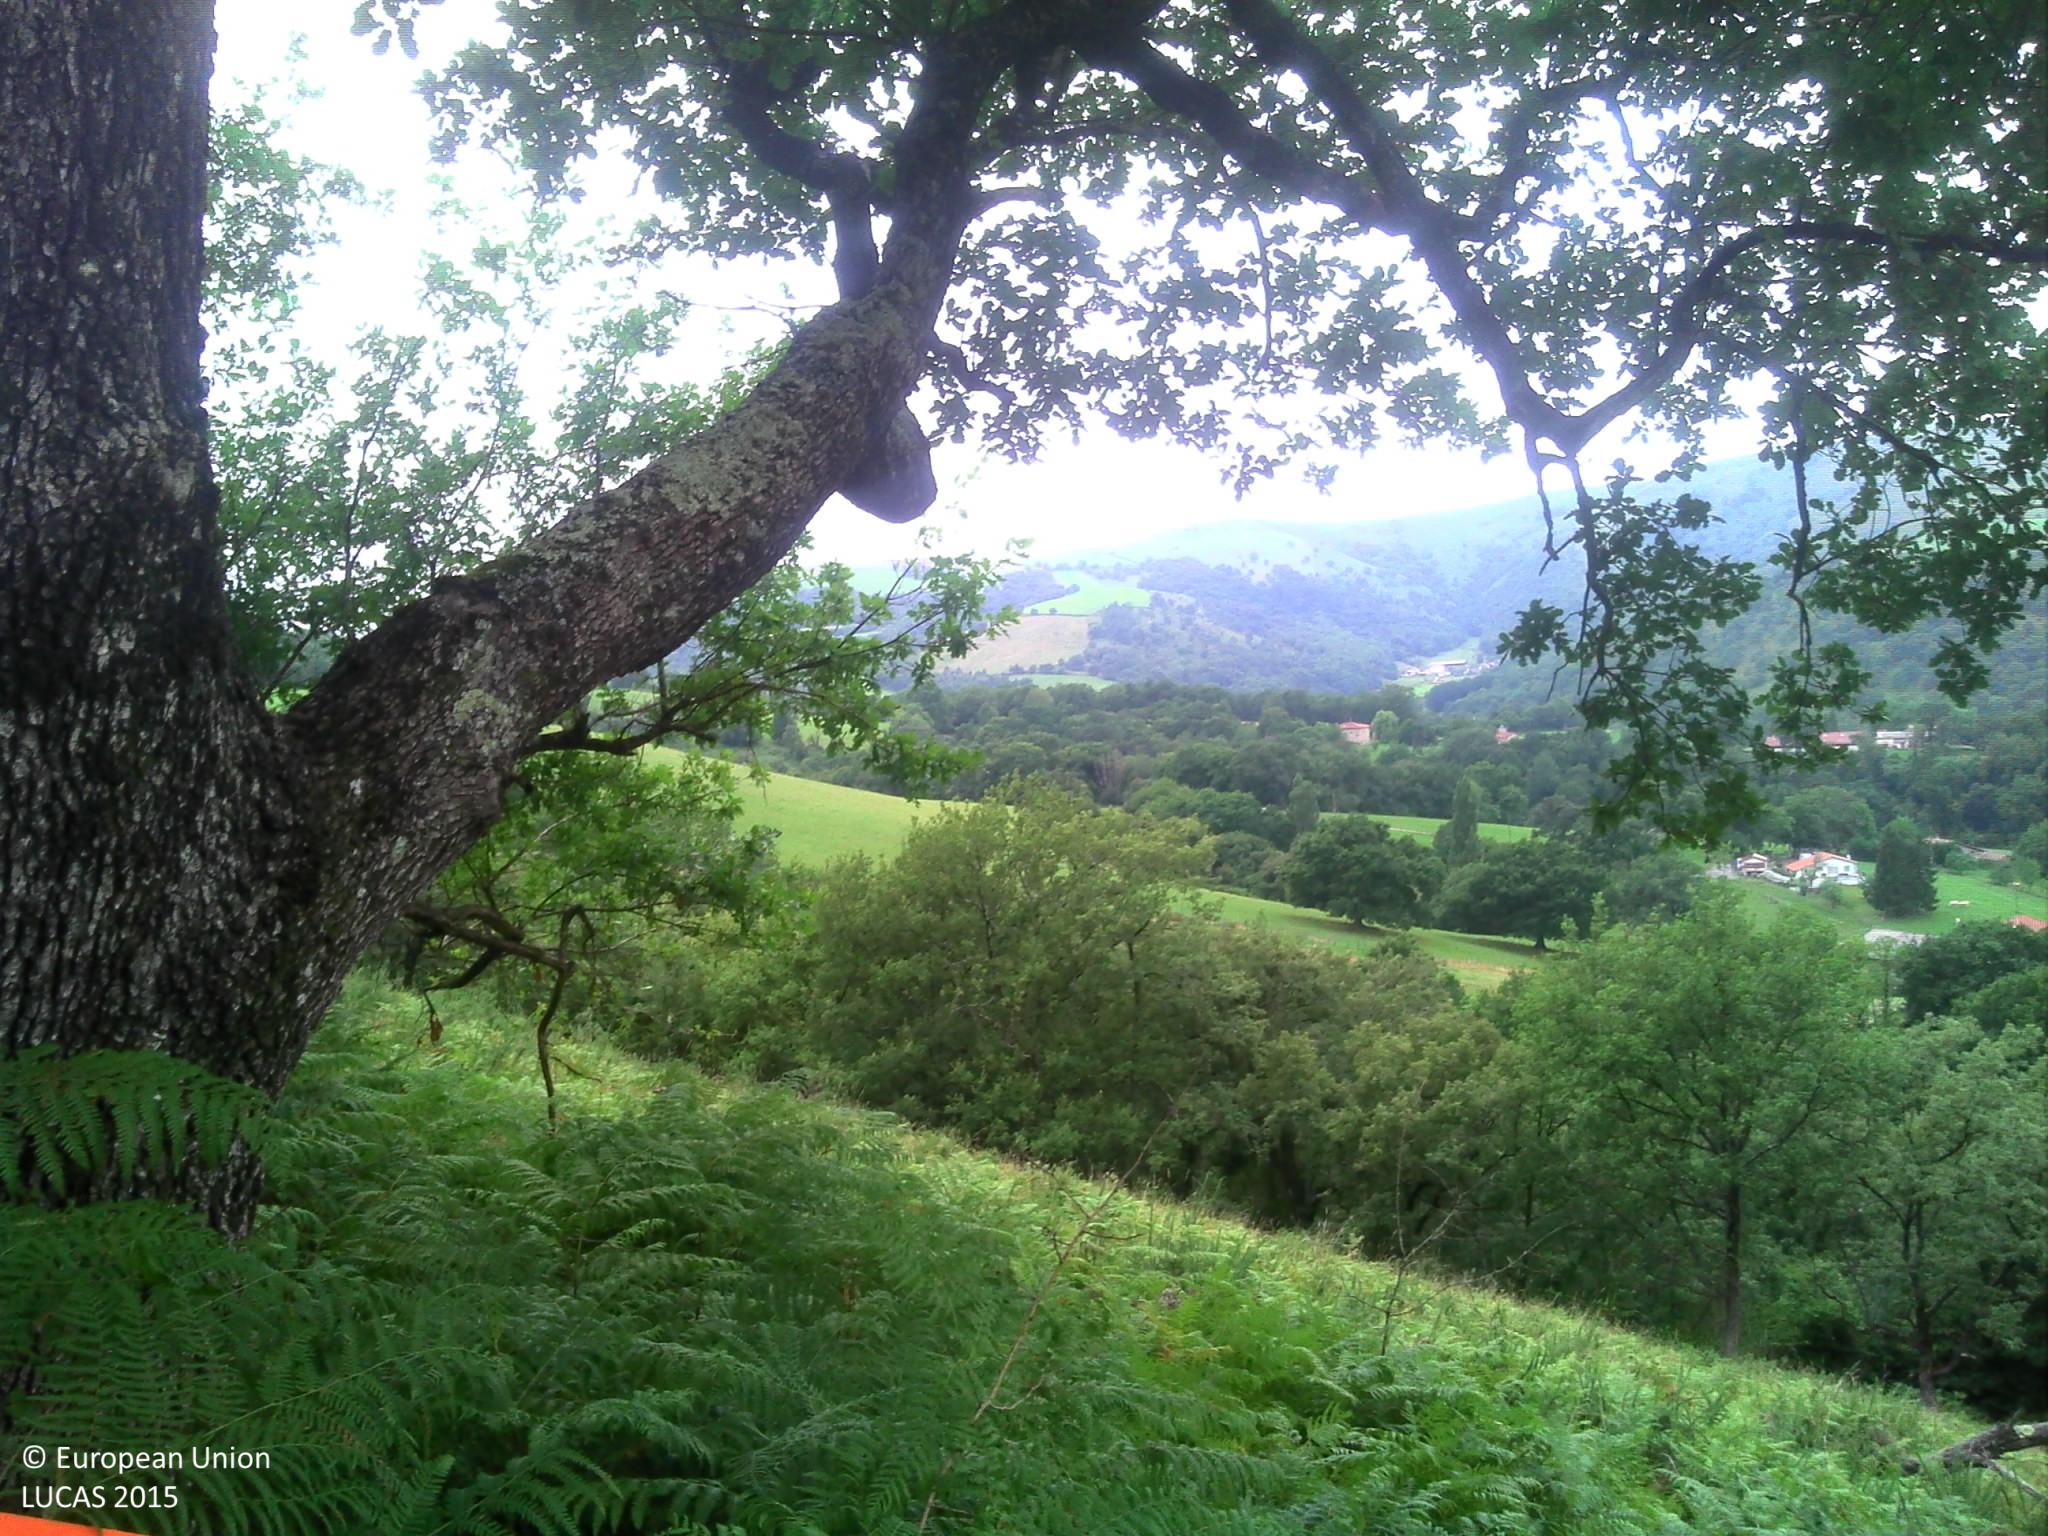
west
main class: Woodland
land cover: Broadleaved woodland
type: thermophilous deciduous forest
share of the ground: > 75 %
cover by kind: broadleaved forest trees 95 %, shrubs 5 %
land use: Forestry
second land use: Agriculture (excluding fallow land and kitchen gardens)
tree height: > 5 m
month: August
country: FR
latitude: 43.2400
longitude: -1.1332
